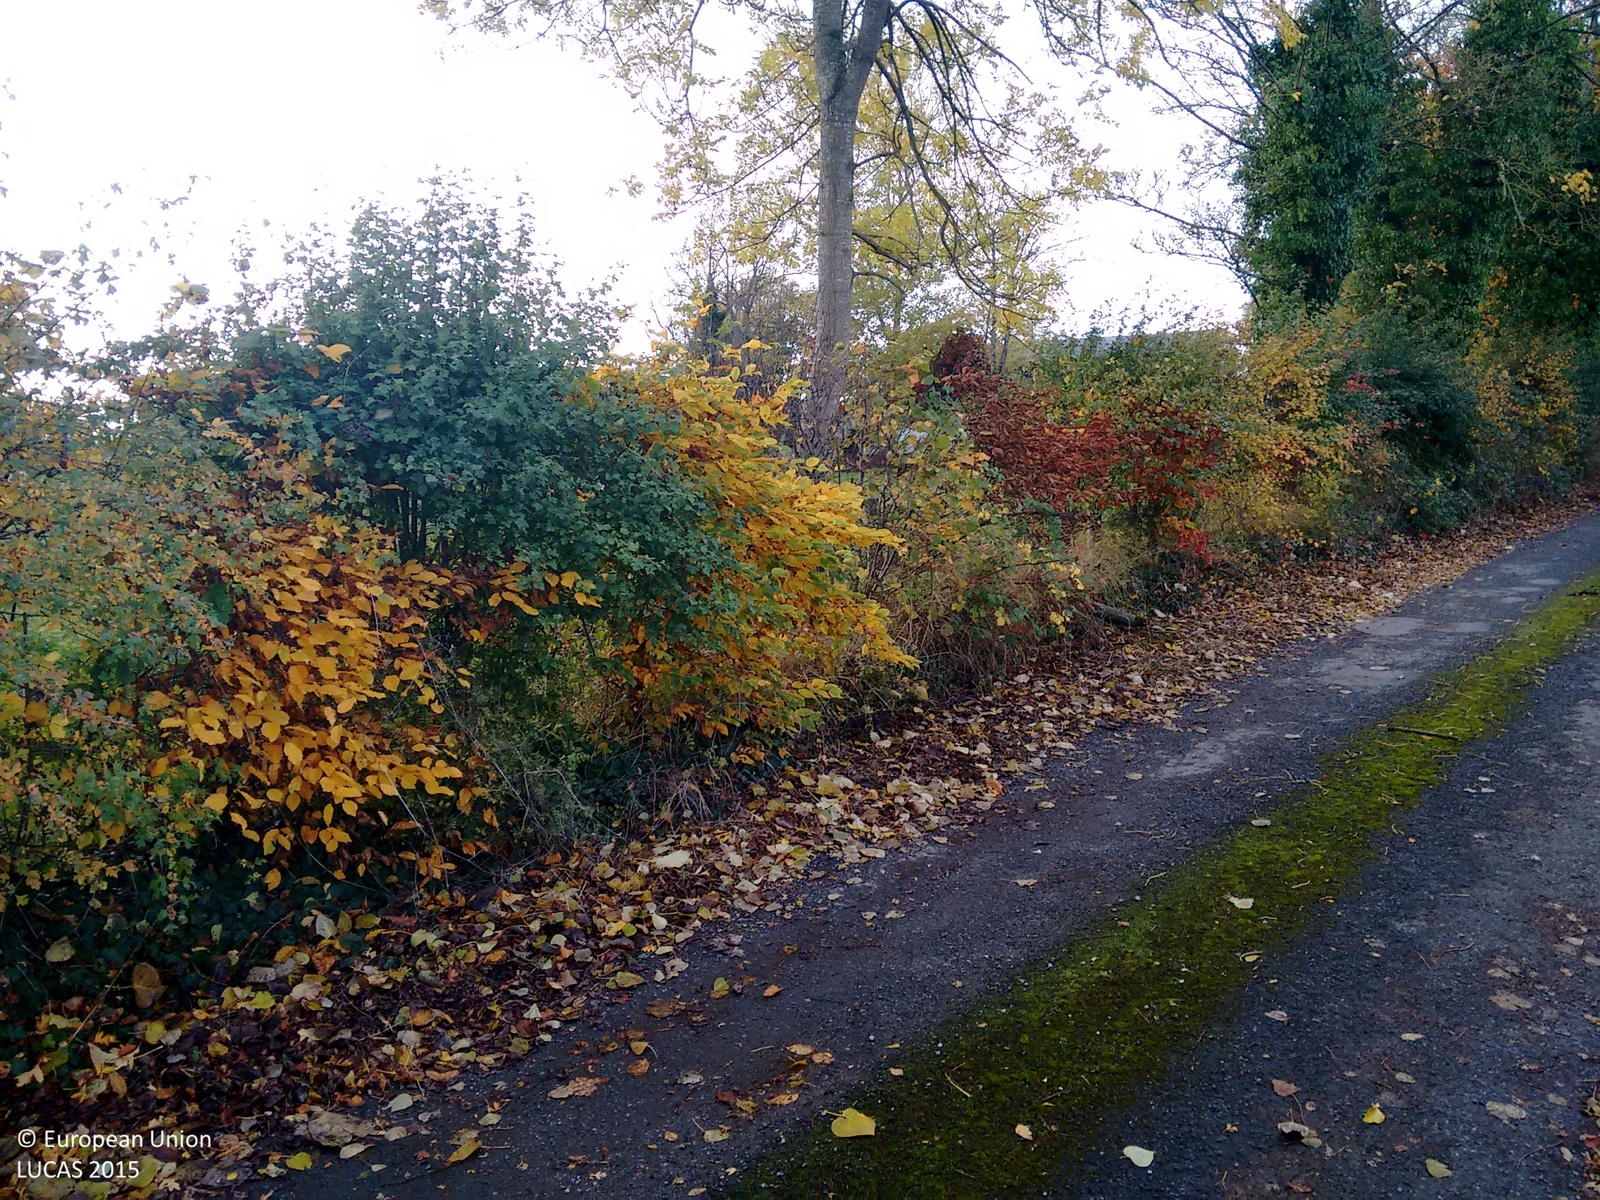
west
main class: Grassland
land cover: Grassland without tree/shrub cover
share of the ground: > 75 %
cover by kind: herbaceous plants 70 %, shrubs 5 %, consolidated bare surface 5 %
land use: Agriculture (excluding fallow land and kitchen gardens)
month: October
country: IE
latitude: 53.1814
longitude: -7.7488
